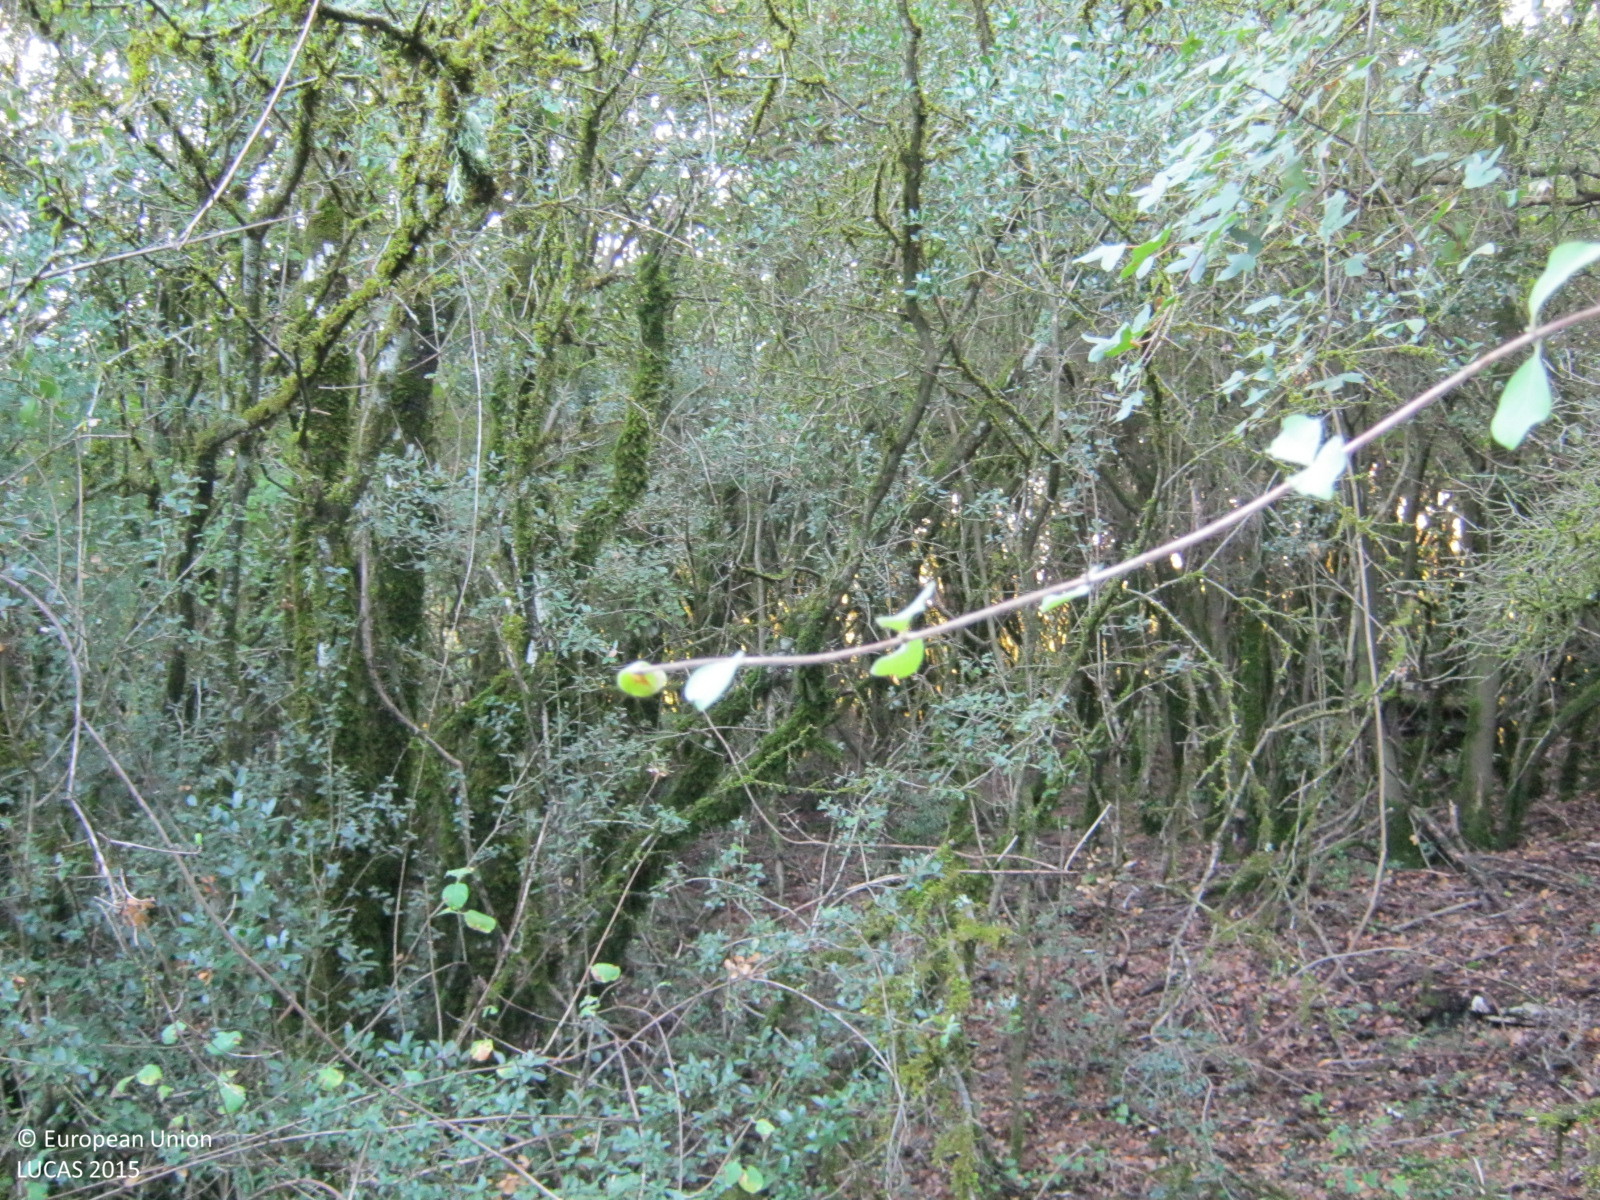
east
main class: Woodland
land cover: Broadleaved woodland
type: broadleaved evergreen forest
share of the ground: 50 - 75 %
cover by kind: broadleaved forest trees 70 %, shrubs 15 %, herbaceous plants 15 %
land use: Semi-natural and natural areas not in use
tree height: > 5 m
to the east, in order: Broadleaved woodland; Dry stone walls; Spontaneously vegetated surfaces; Dry stone walls; Spontaneously vegetated surfaces; Abandoned hedges; Spontaneously vegetated surfaces; Broadleaved woodland
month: October
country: GR
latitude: 39.5636
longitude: 20.7668
